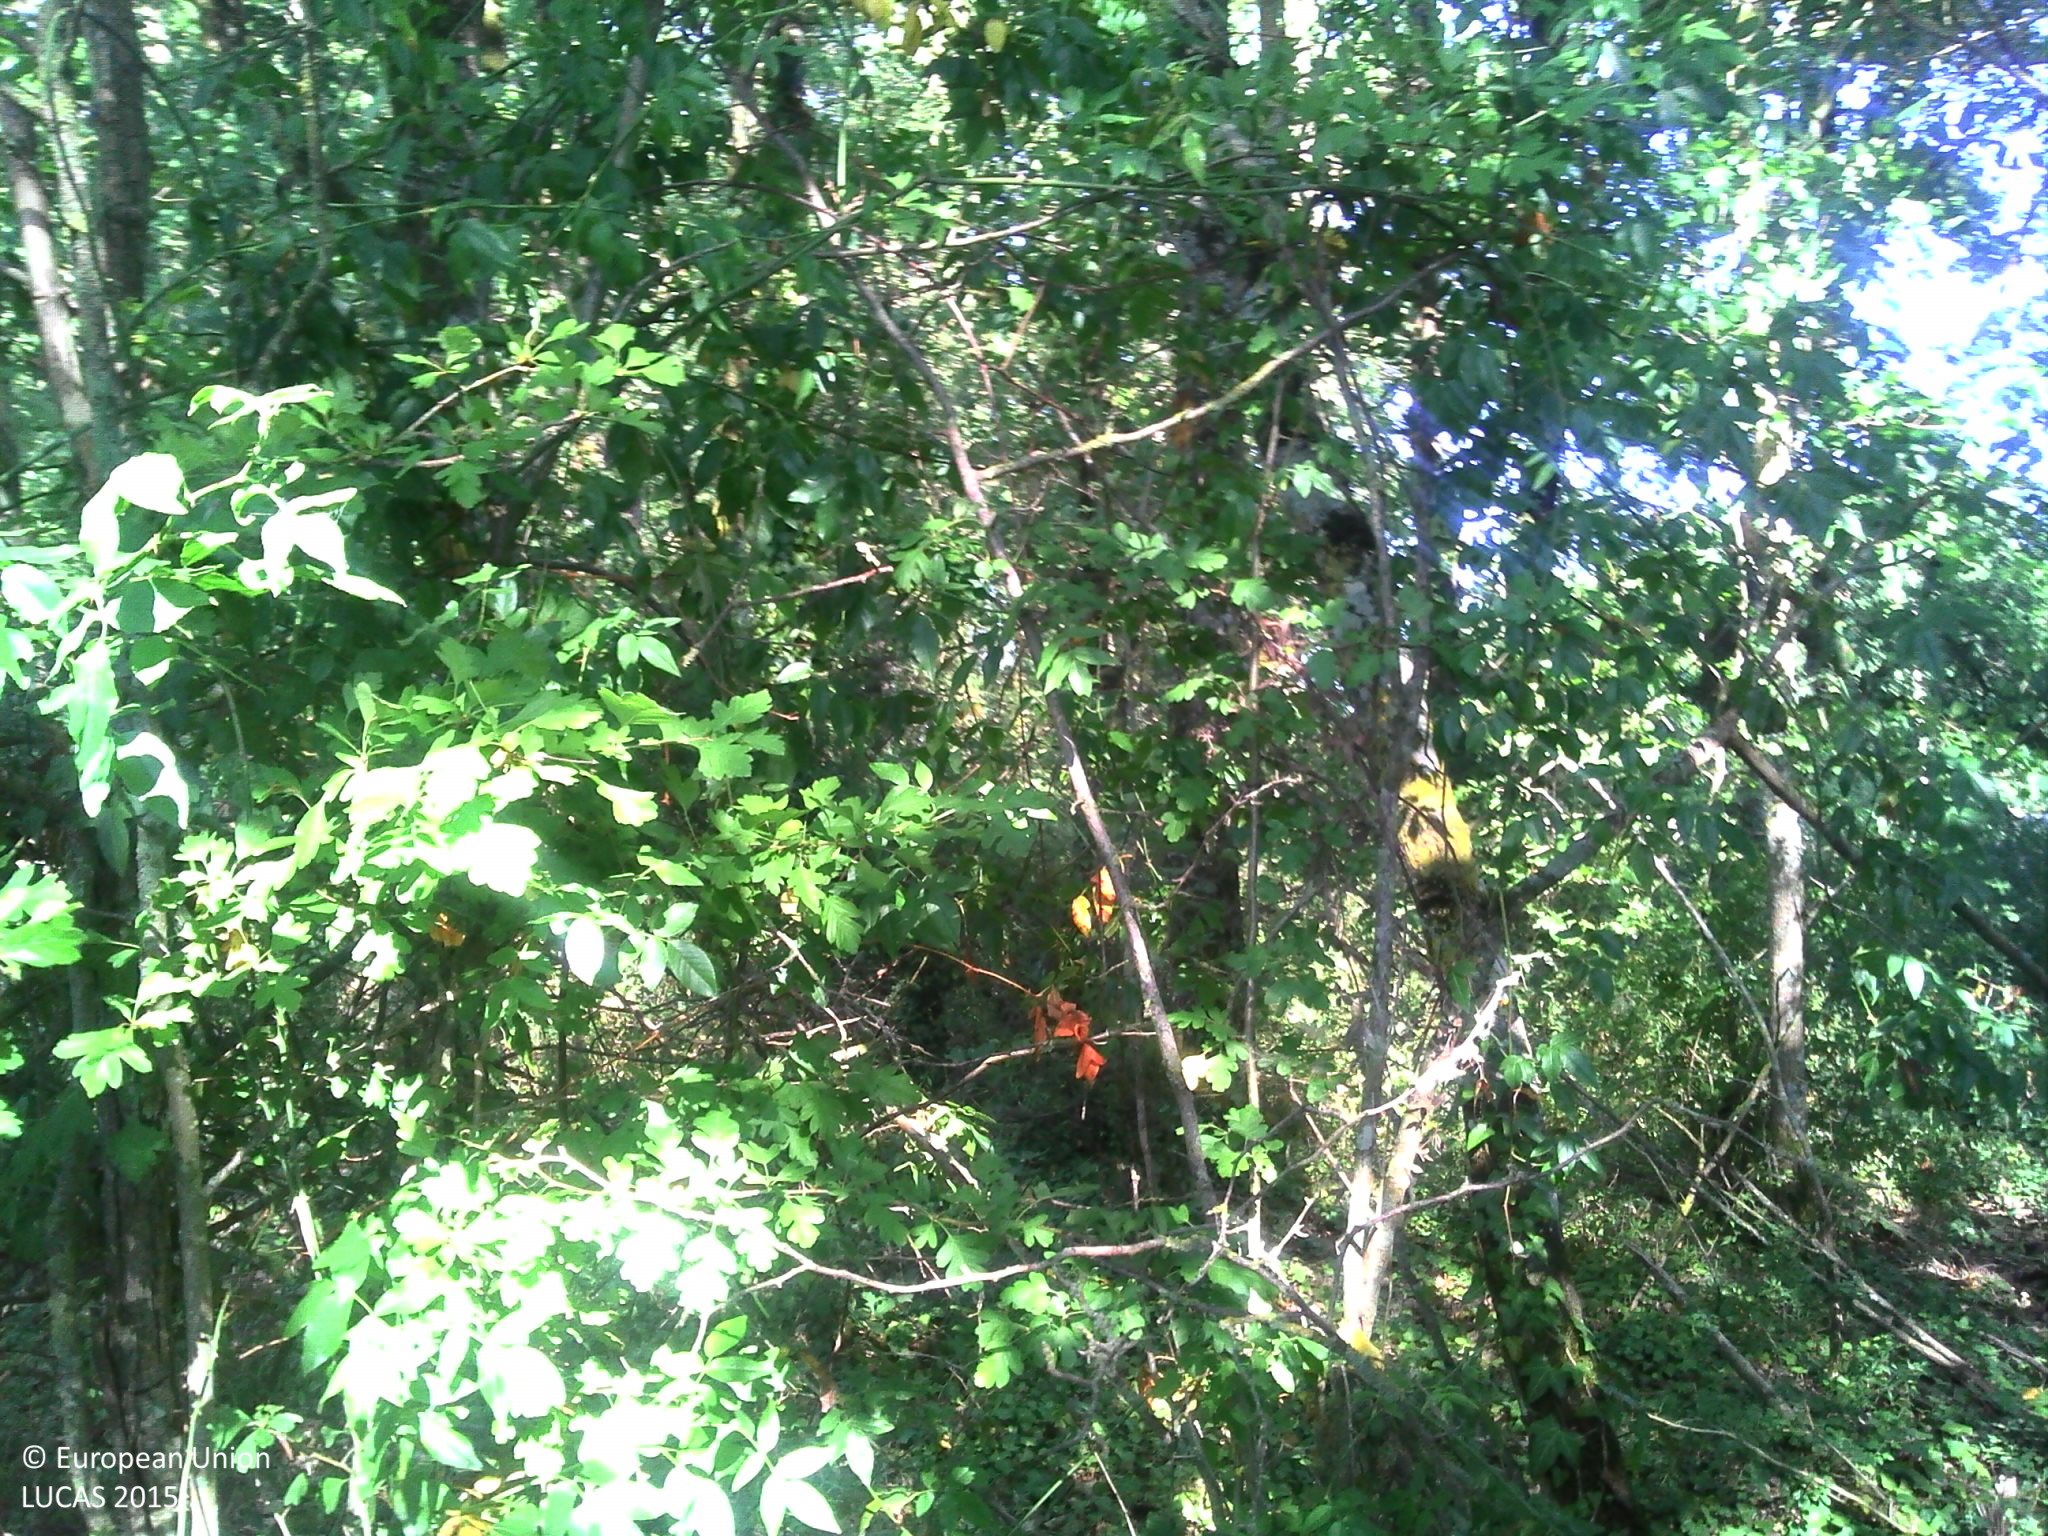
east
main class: Woodland
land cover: Broadleaved woodland
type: thermophilous deciduous forest
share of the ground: > 75 %
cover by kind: broadleaved forest trees 80 %, shrubs 10 %, herbaceous plants 10 %
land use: Forestry
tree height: > 5 m
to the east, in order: Broadleaved woodland; Ditches and canals; Grass margins; Paved roads, cycling and walking lanes; Grass margins; Electric lines; Grass margins; Maize
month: July
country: FR
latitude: 43.8442
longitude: 0.7308
